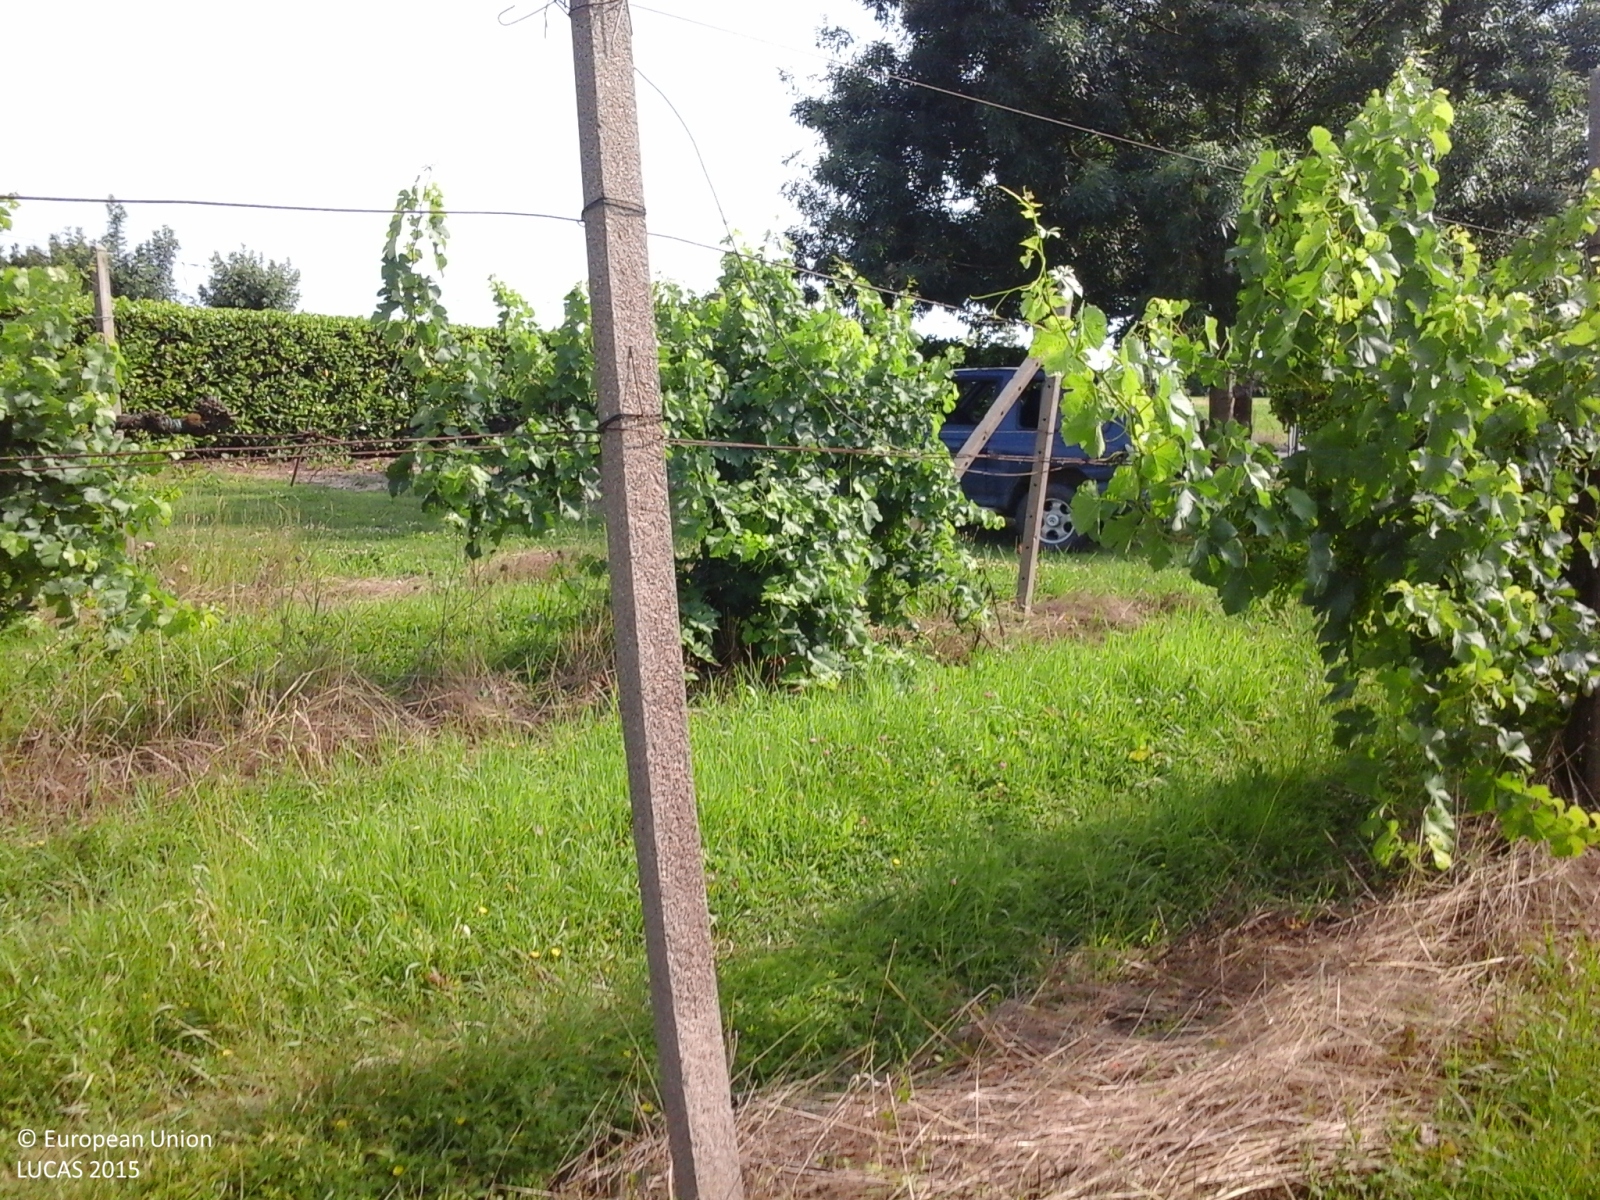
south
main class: Cropland
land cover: Vineyards
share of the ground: 10 - 25 %
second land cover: Grassland without tree/shrub cover
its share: > 75 %
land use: Agriculture (excluding fallow land and kitchen gardens)
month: June
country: IT
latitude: 45.7762
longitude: 12.7099
